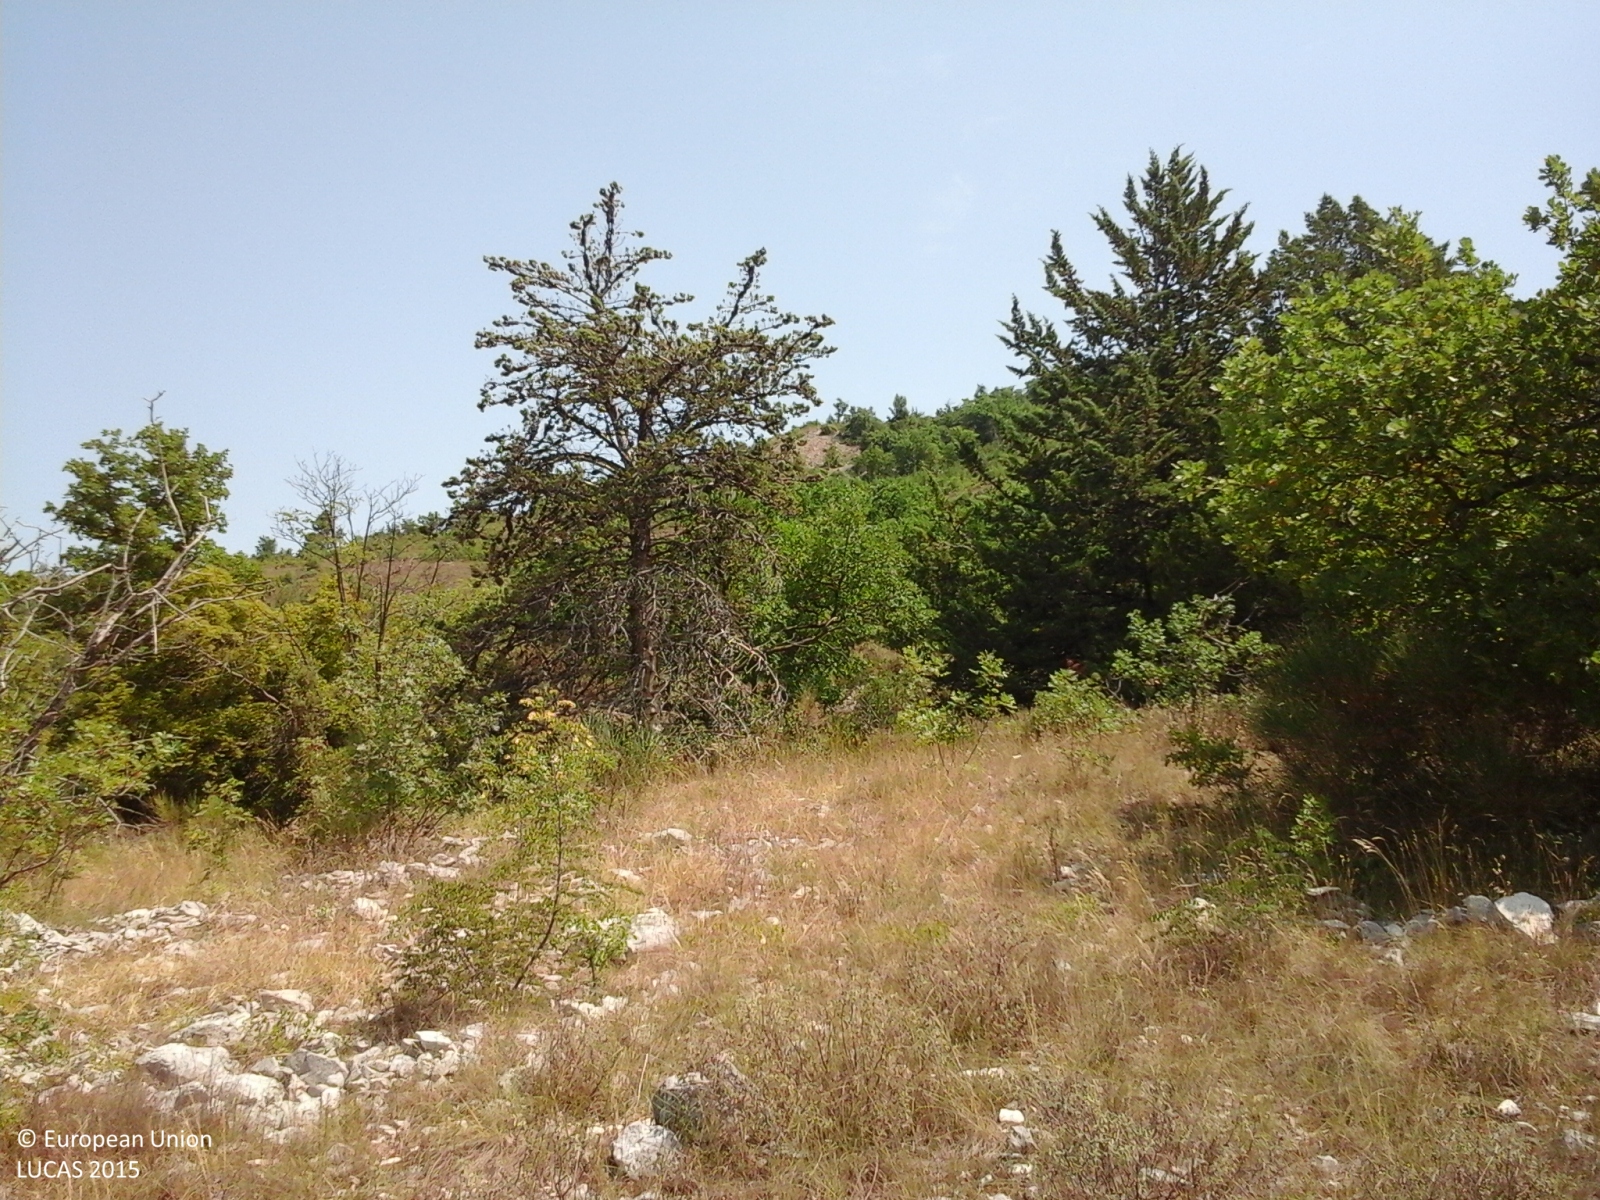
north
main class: Grassland
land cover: Grassland without tree/shrub cover
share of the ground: > 75 %
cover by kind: herbaceous plants 100 %
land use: Semi-natural and natural areas not in use
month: July
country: IT
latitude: 42.1840
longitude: 13.8257
